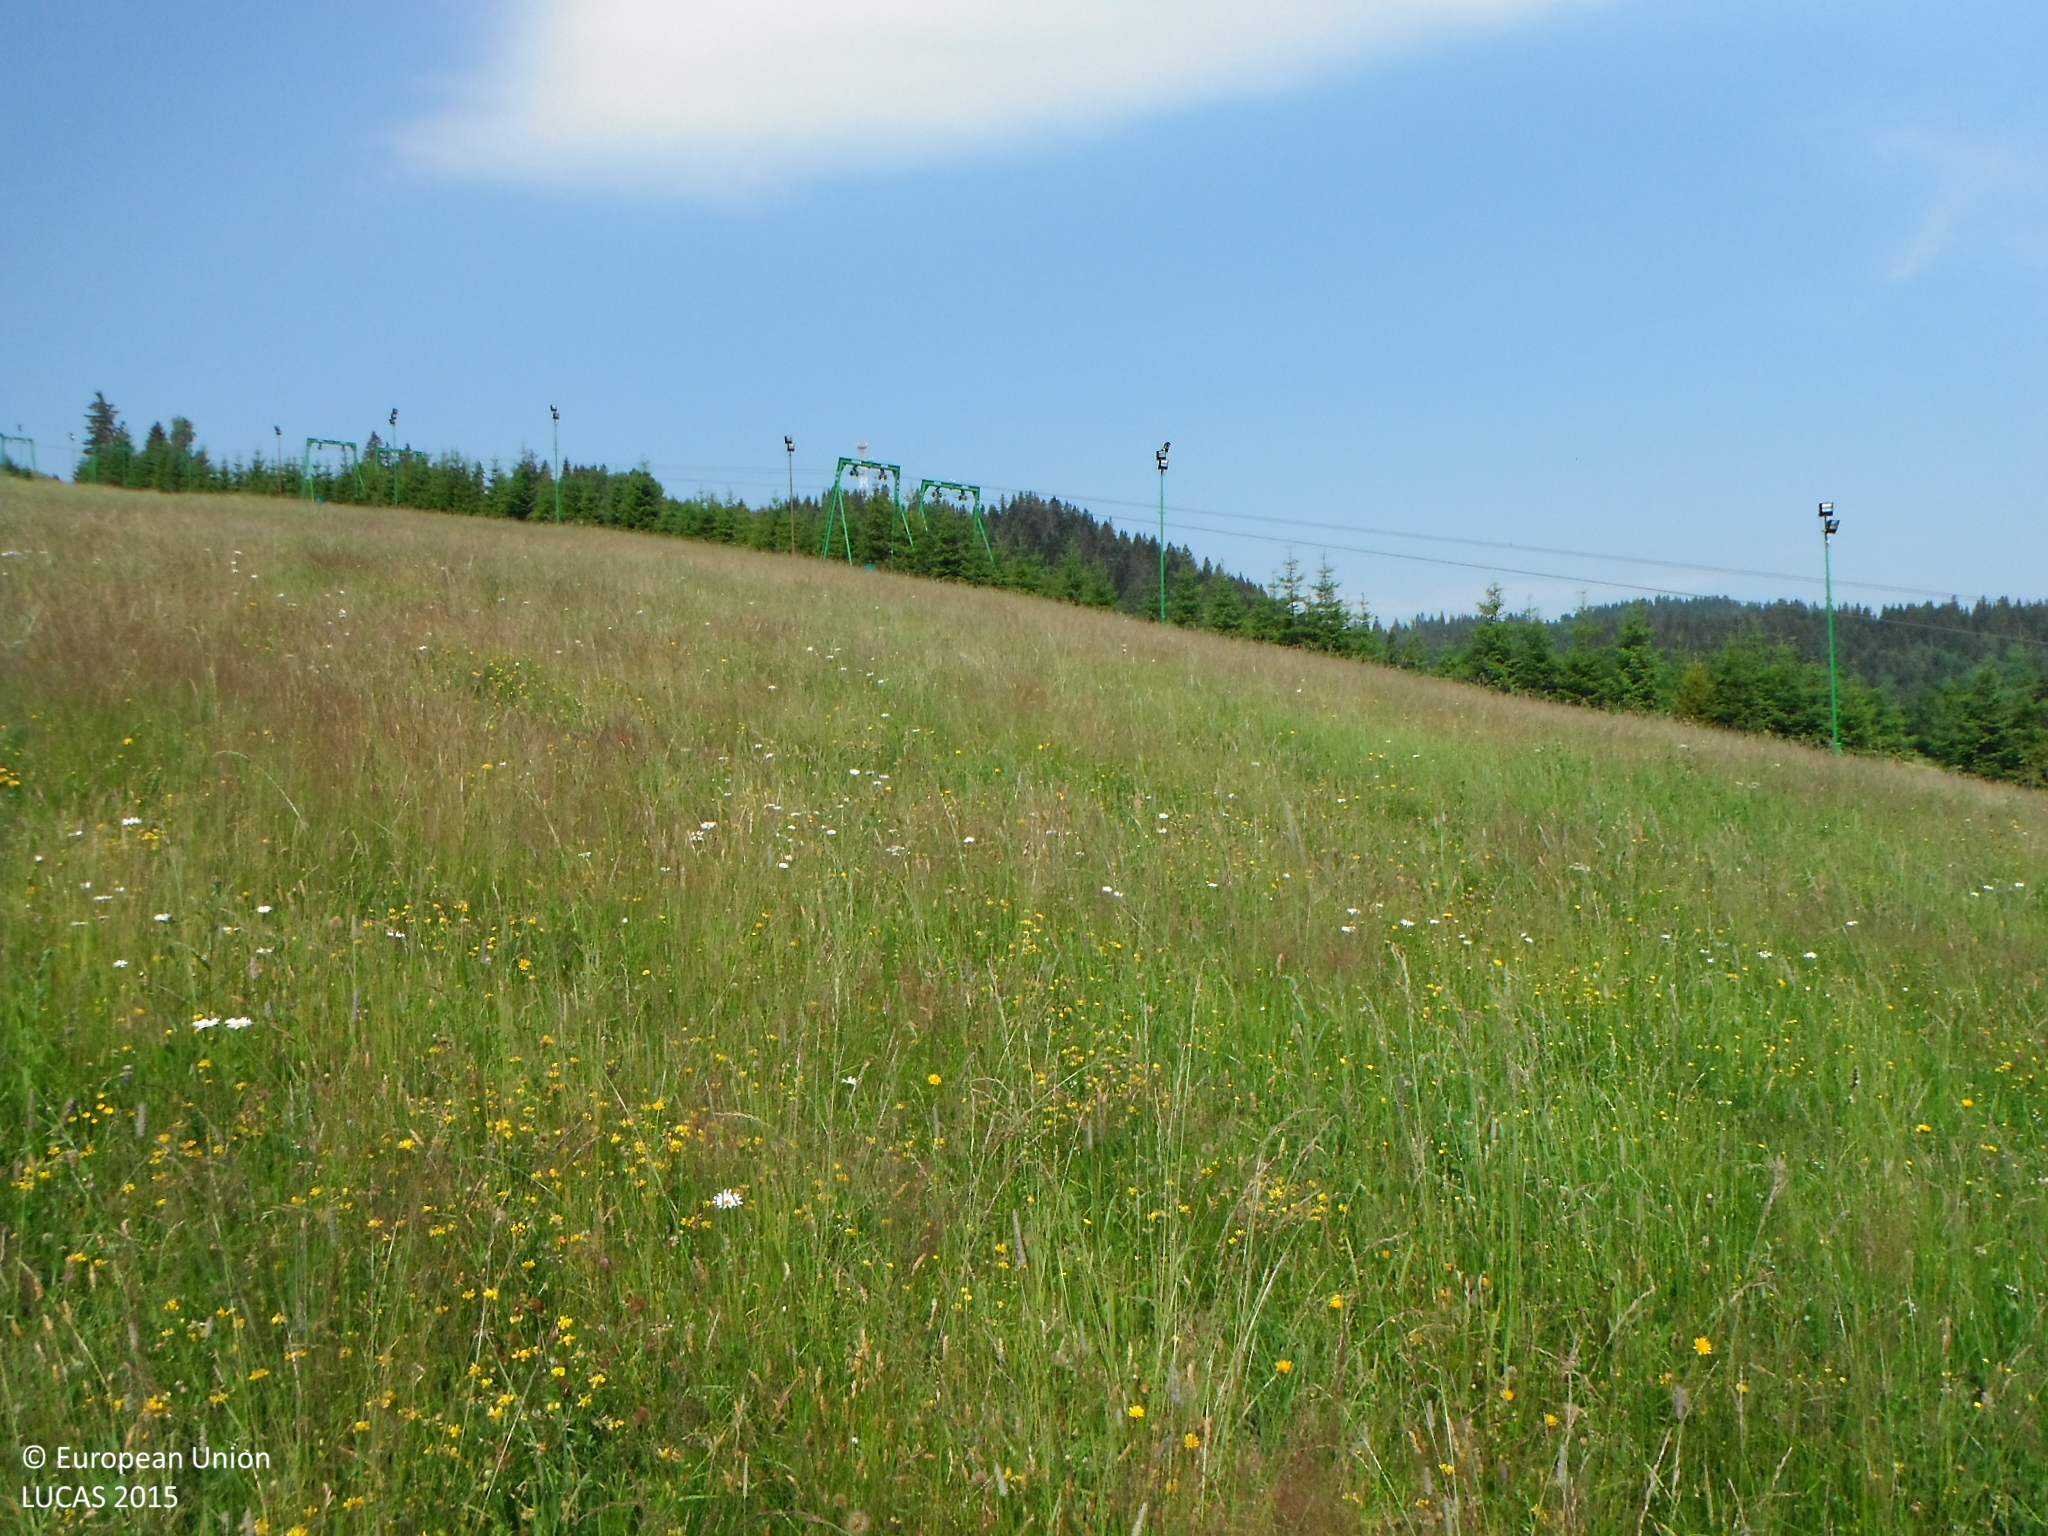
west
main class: Grassland
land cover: Grassland without tree/shrub cover
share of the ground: > 75 %
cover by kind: herbaceous plants 100 %
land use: Agriculture (excluding fallow land and kitchen gardens)
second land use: Sport
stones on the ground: < 10 %
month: July
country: SK
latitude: 49.5207
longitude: 19.4333
